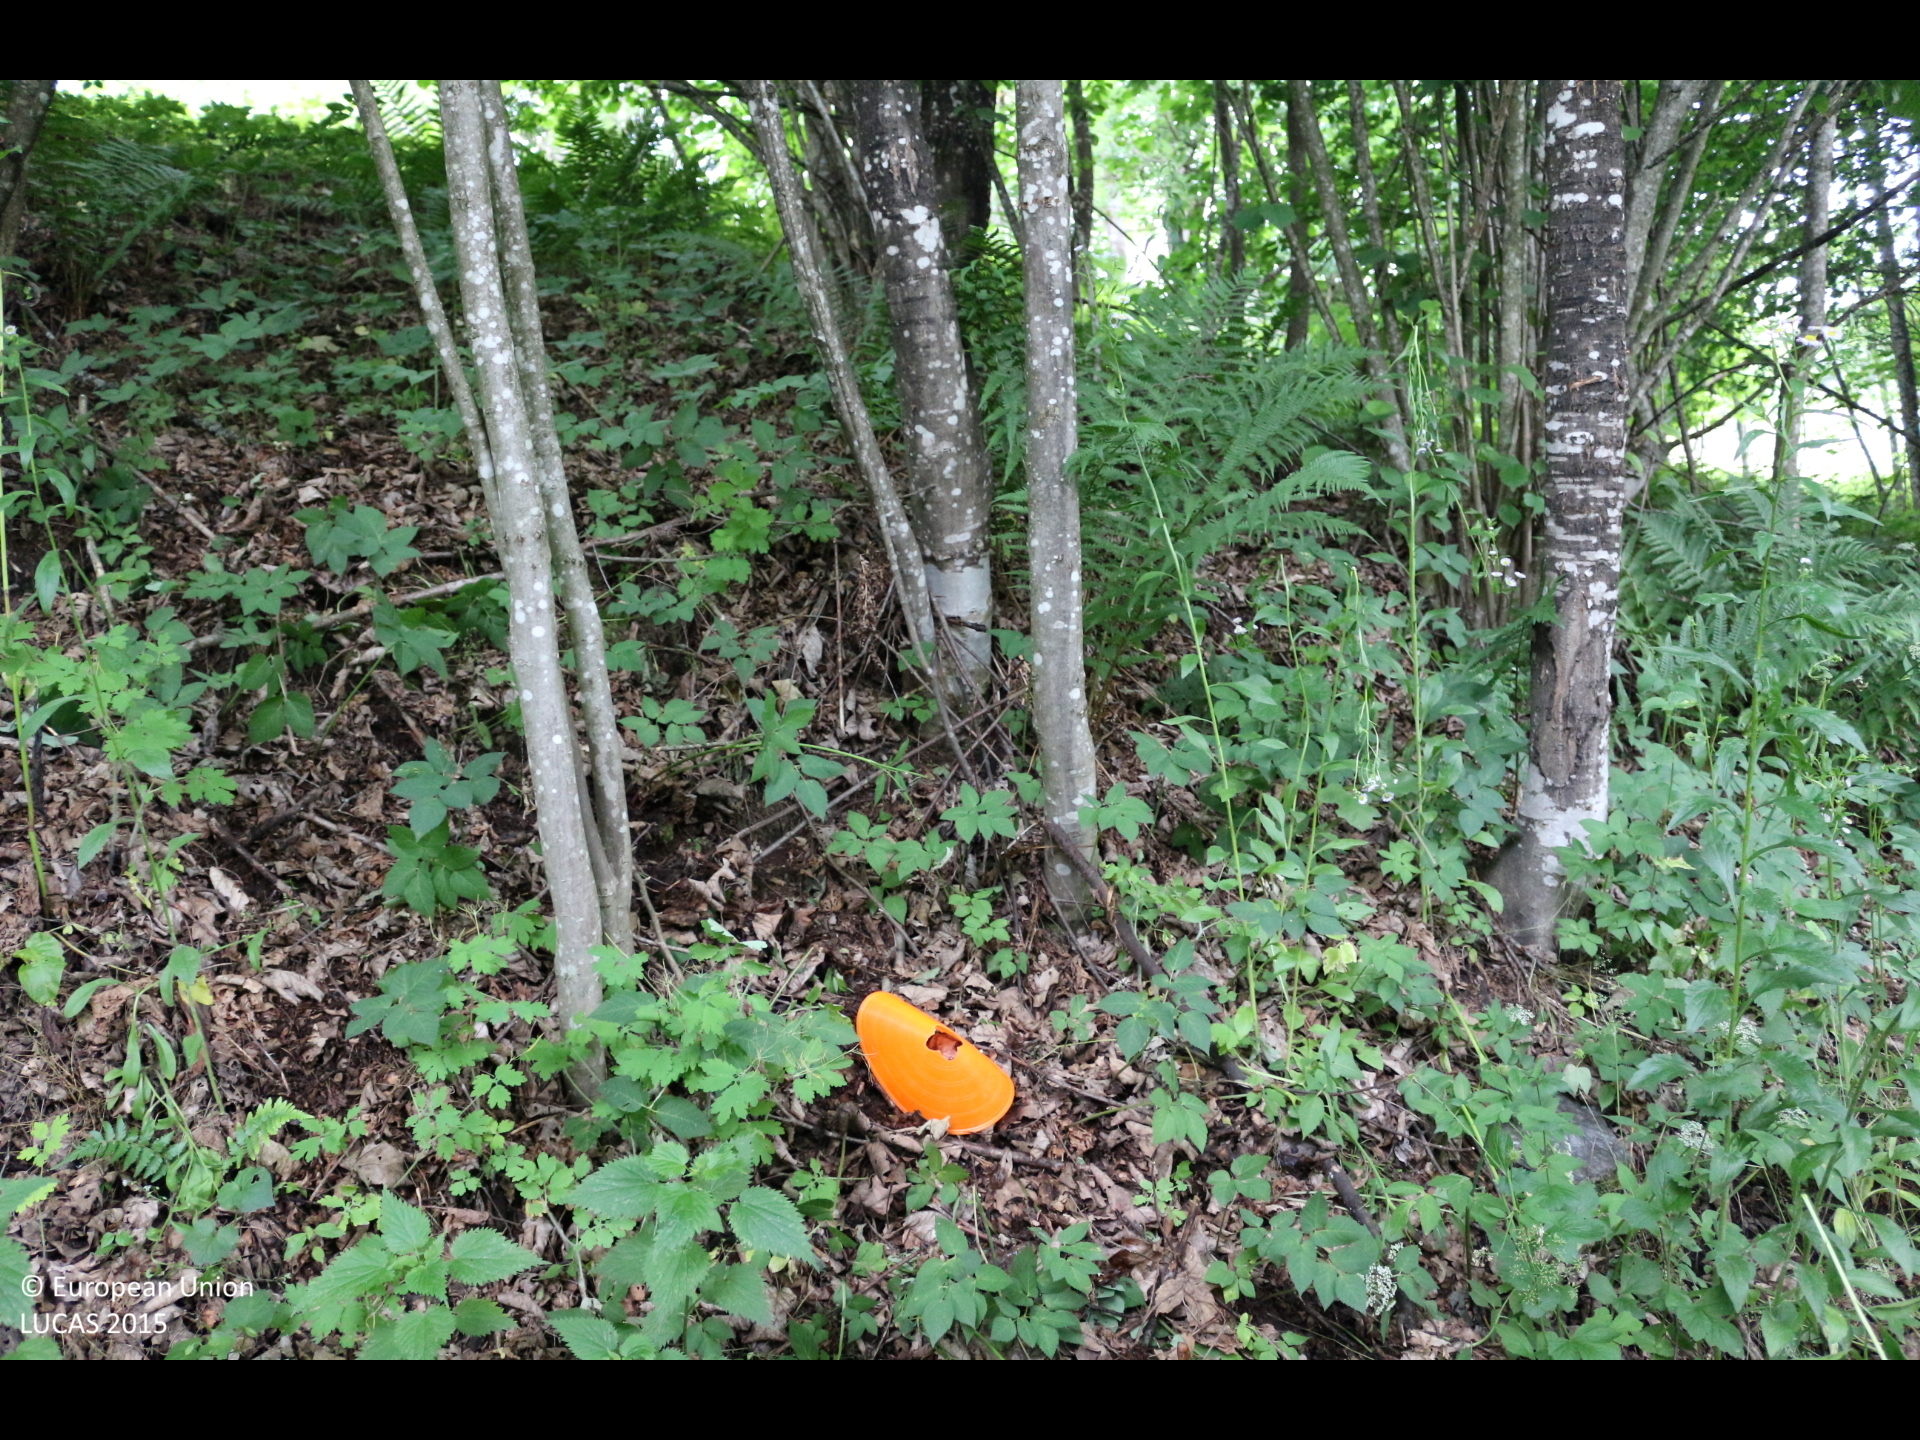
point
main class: Woodland
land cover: Broadleaved woodland
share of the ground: > 75 %
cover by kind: broadleaved forest trees 90 %, herbaceous plants 10 %
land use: Forestry
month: June
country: AT
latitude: 46.8784
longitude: 14.2886
